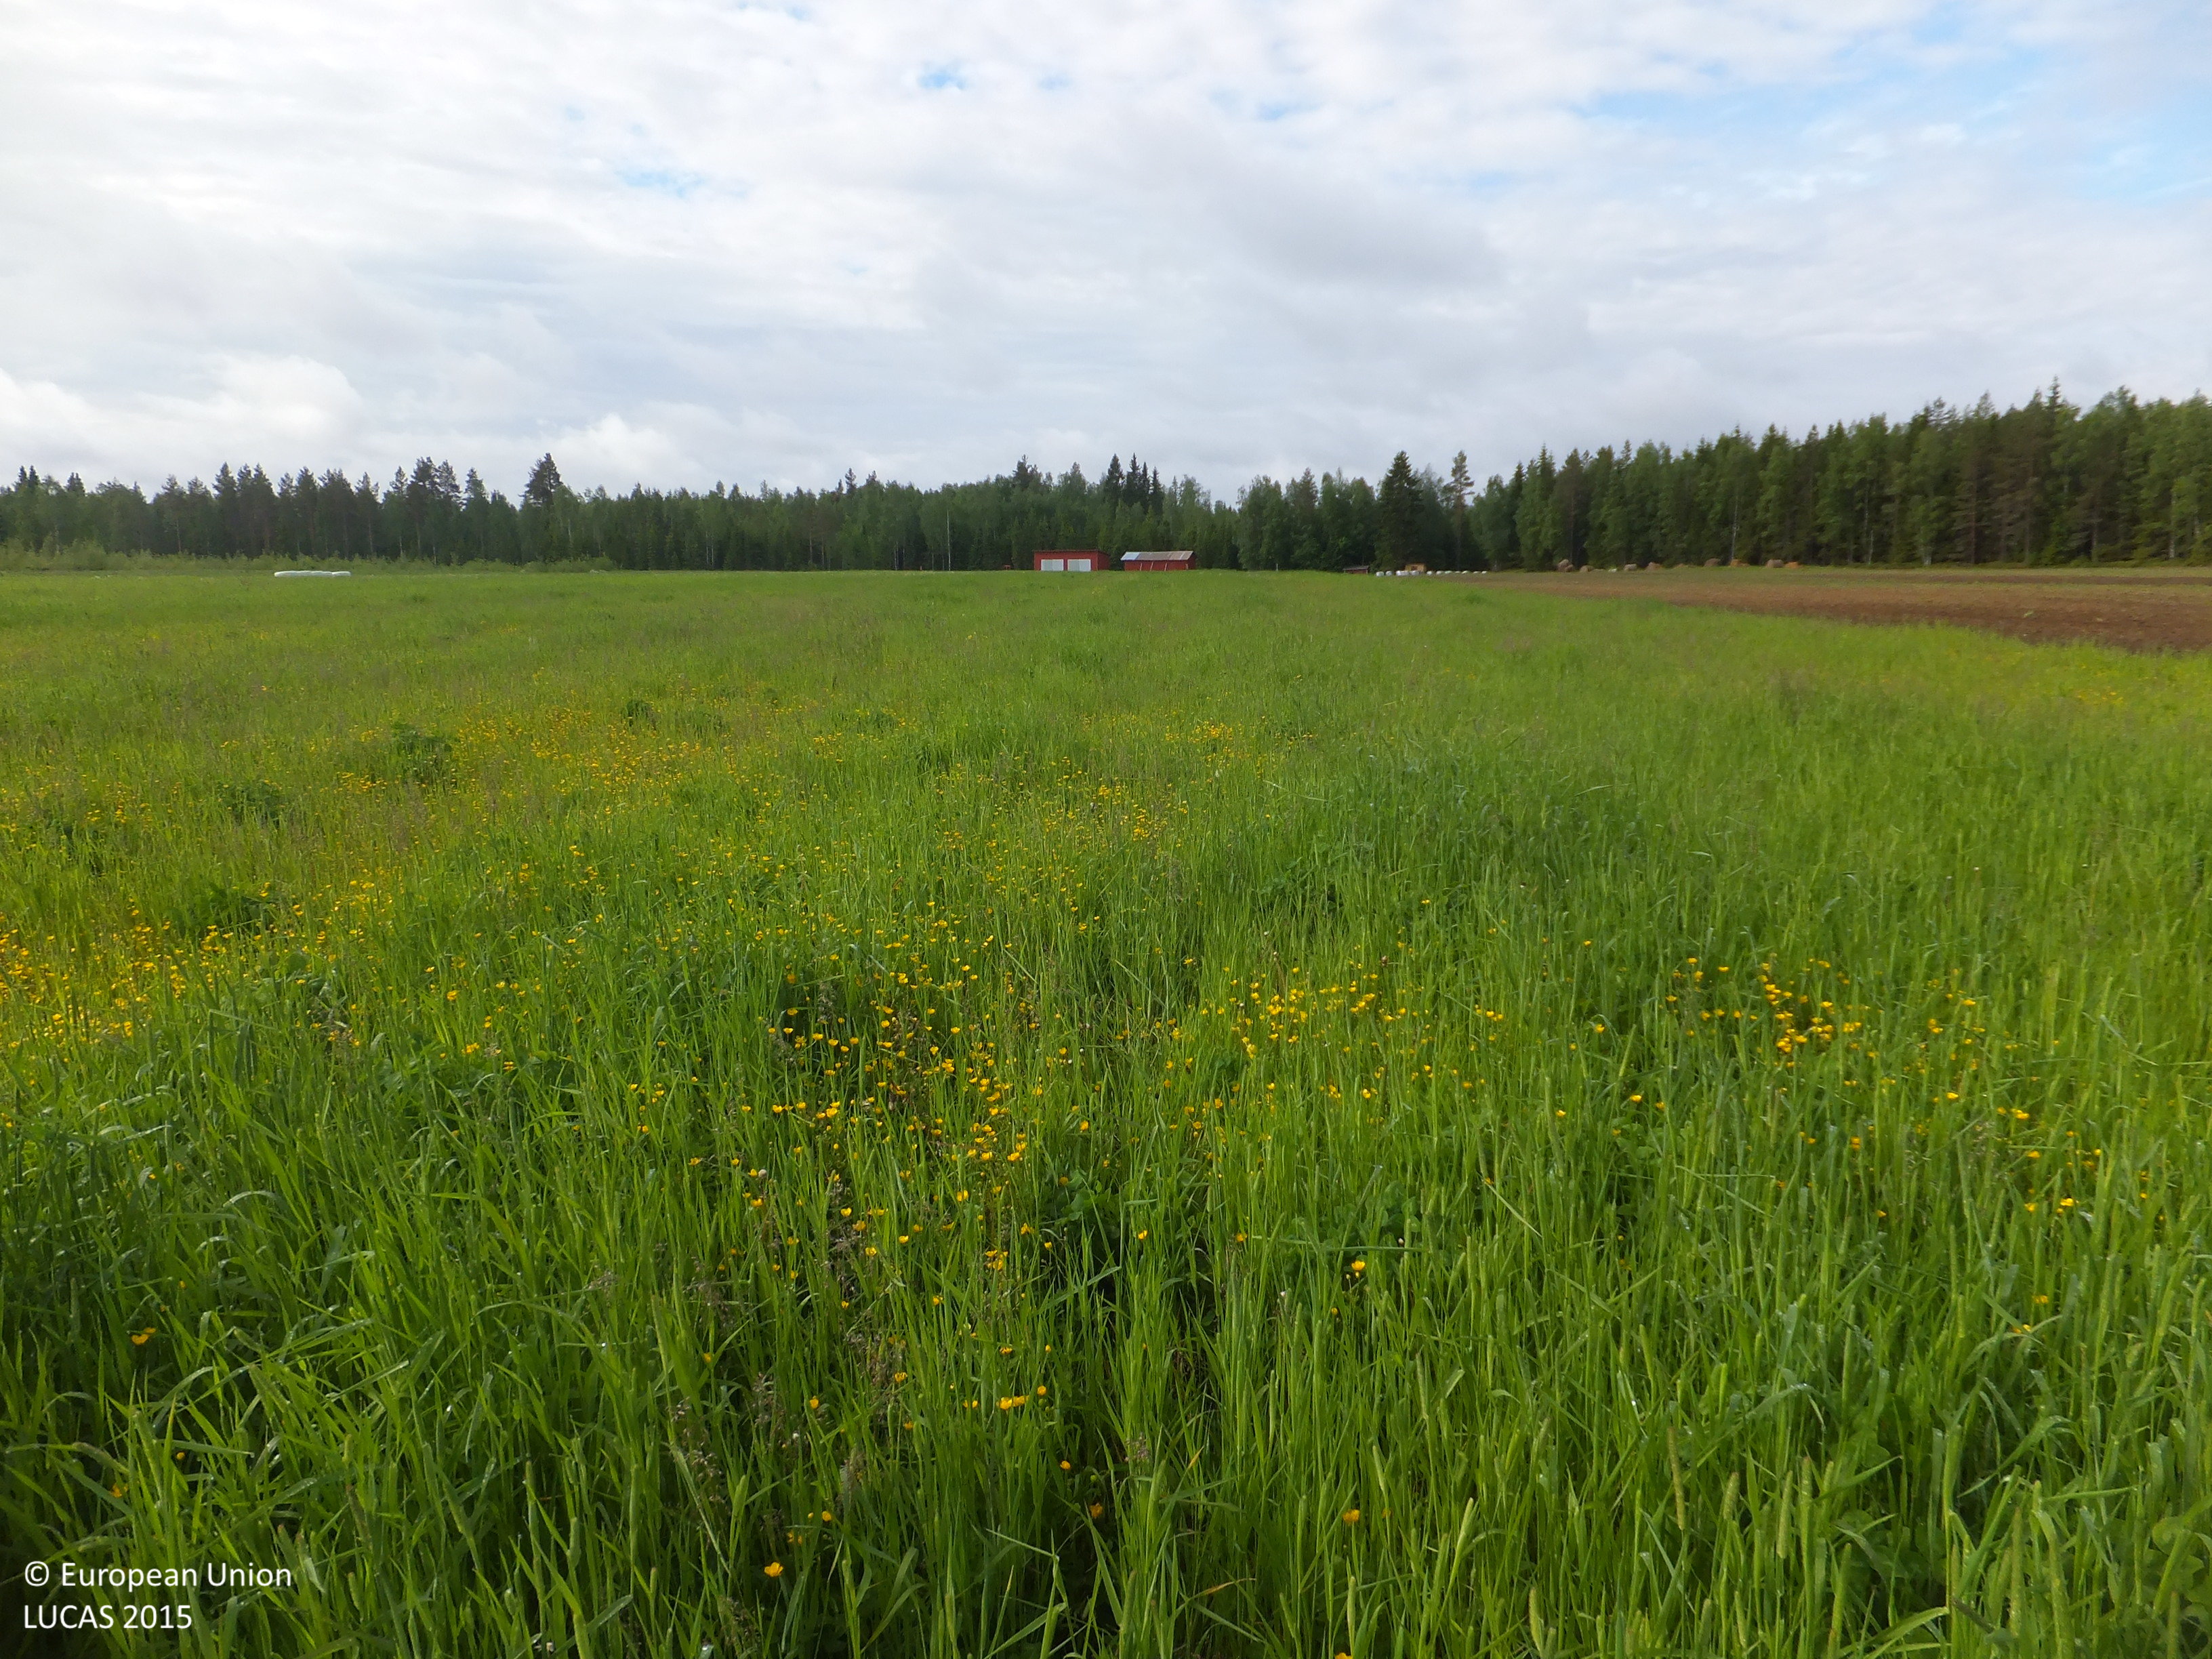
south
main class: Cropland
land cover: Temporary grasslands
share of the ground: > 75 %
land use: Agriculture (excluding fallow land and kitchen gardens)
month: June
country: FI
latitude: 63.3680
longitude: 24.0090
